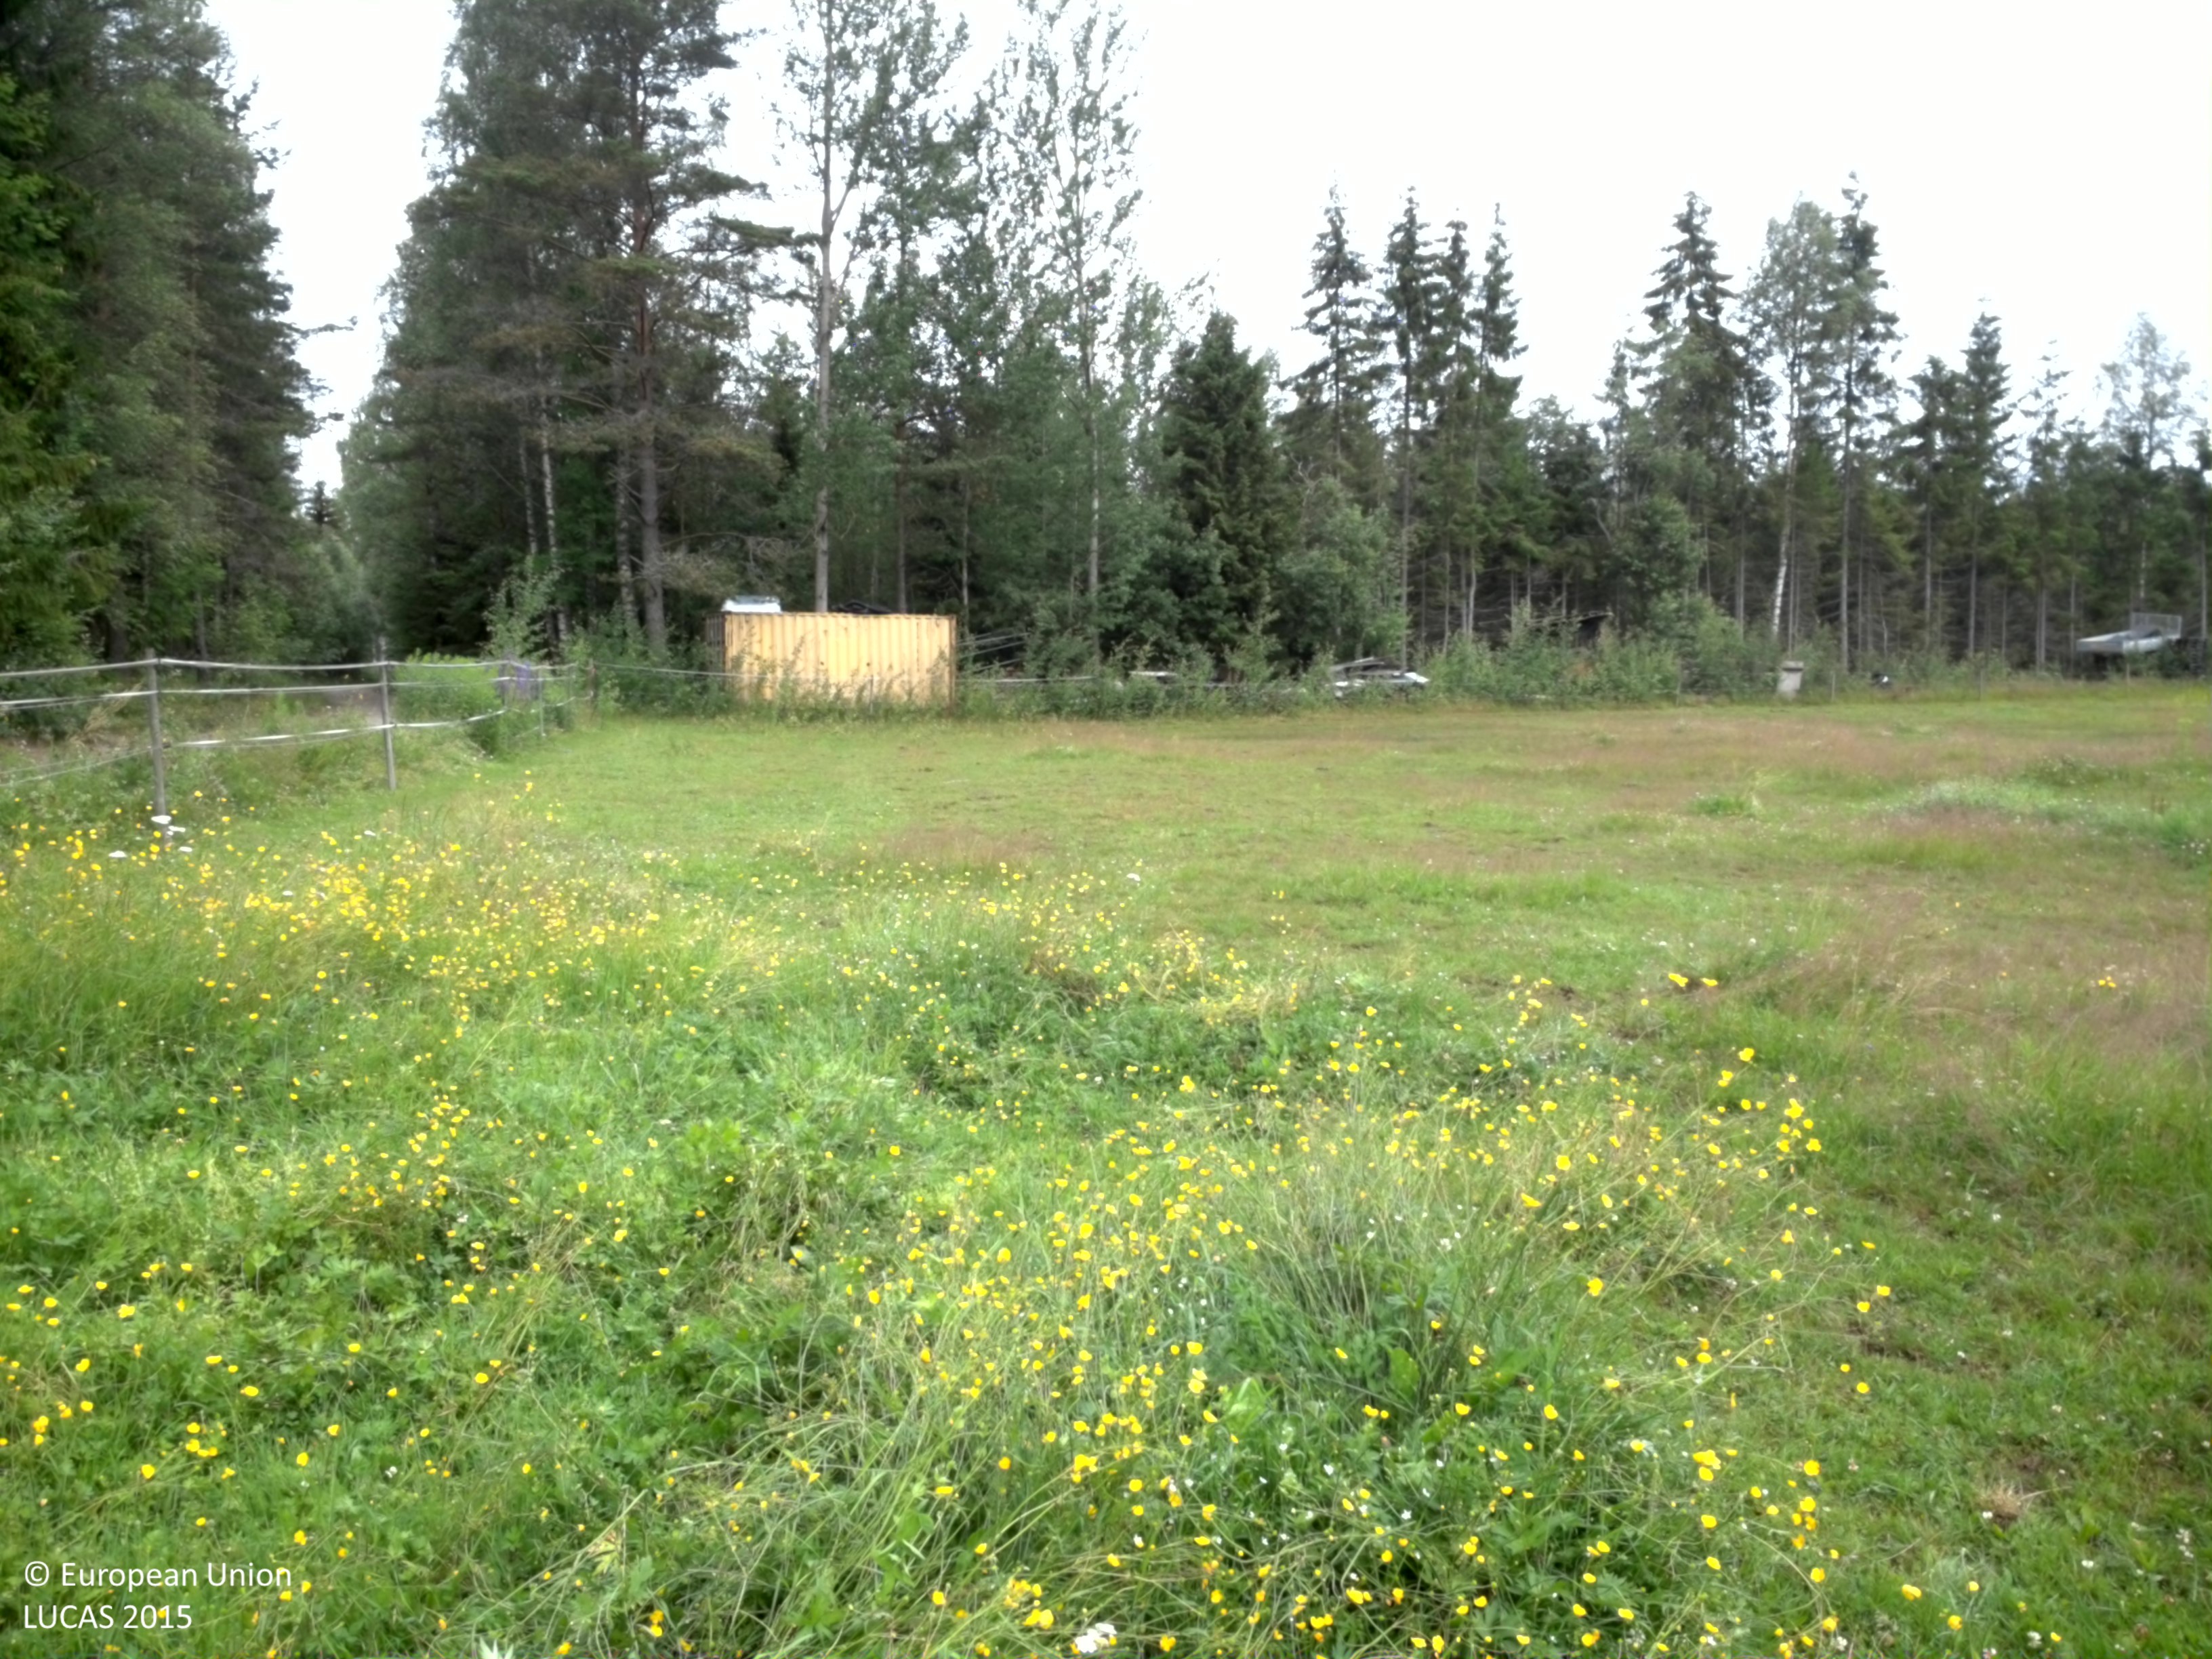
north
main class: Grassland
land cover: Grassland without tree/shrub cover
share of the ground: > 75 %
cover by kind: herbaceous plants 95 %, unconsolidated bare surface 5 %
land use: Agriculture (excluding fallow land and kitchen gardens)
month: July
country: SE
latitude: 59.7485
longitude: 14.4925
